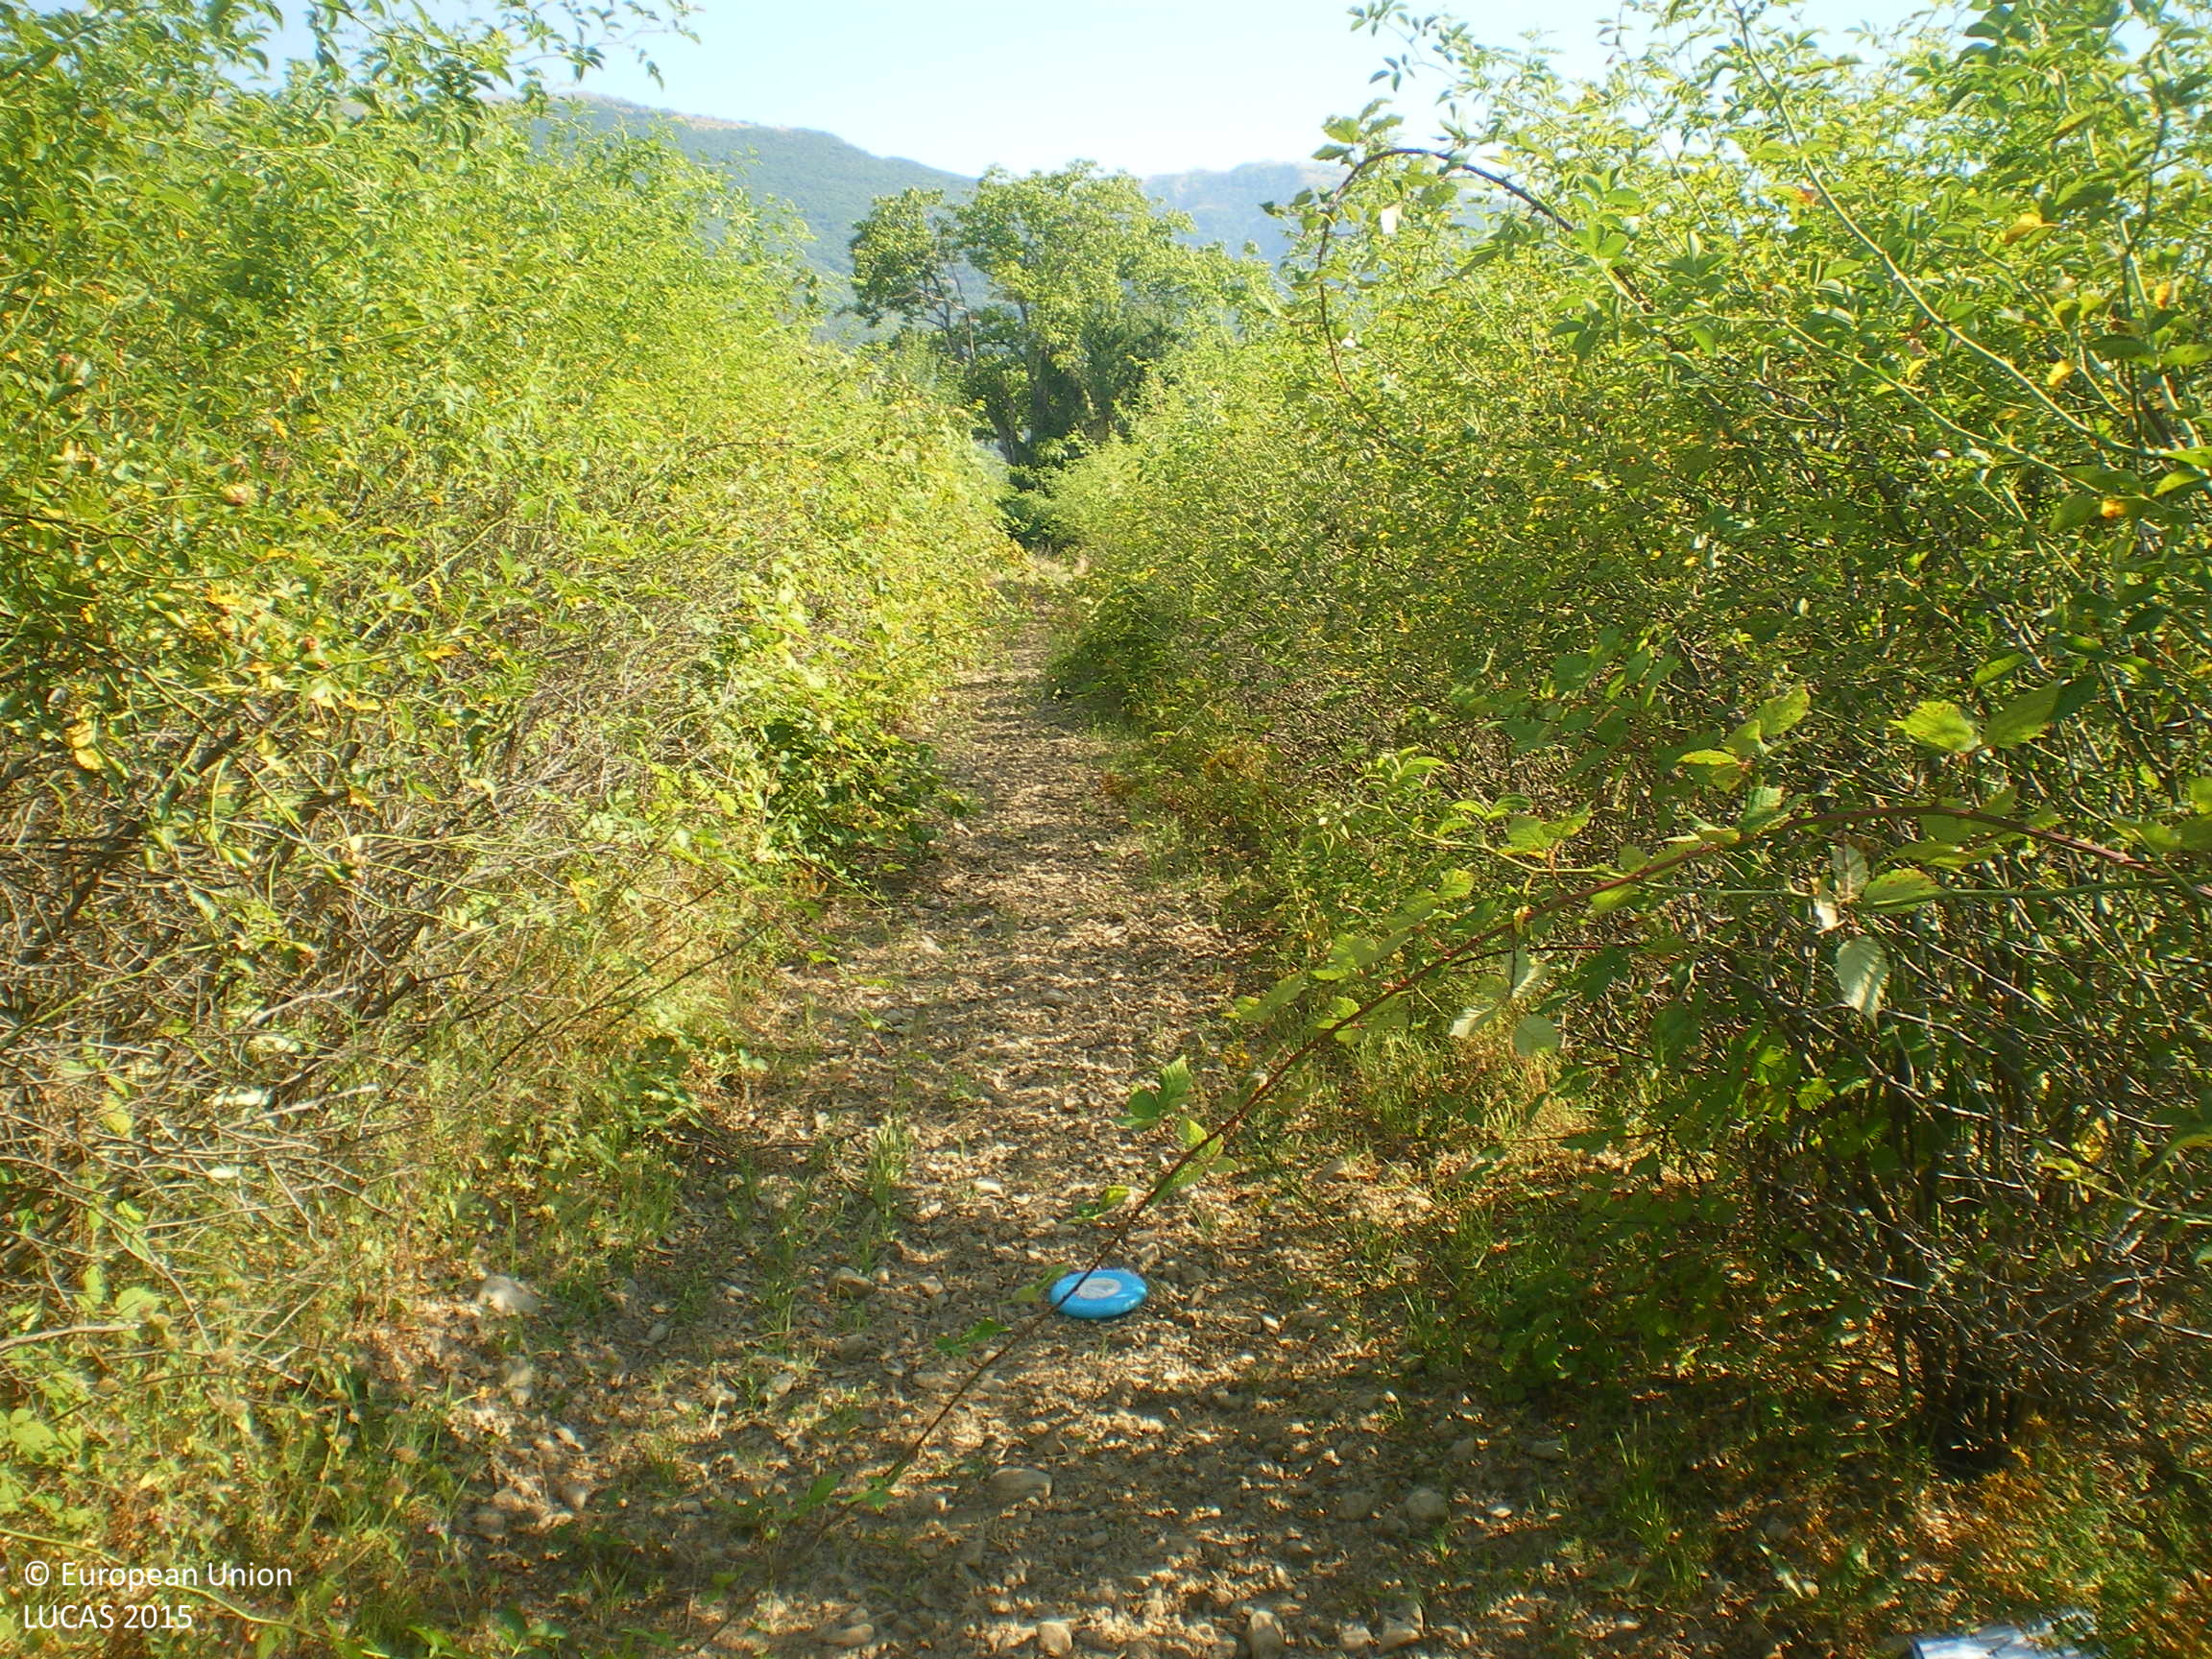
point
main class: Cropland
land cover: Permanent industrial crops
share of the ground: > 75 %
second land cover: Spontaneously vegetated surfaces
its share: < 10 %
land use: Agriculture (excluding fallow land and kitchen gardens)
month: July
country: BG
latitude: 42.6472
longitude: 25.1279
